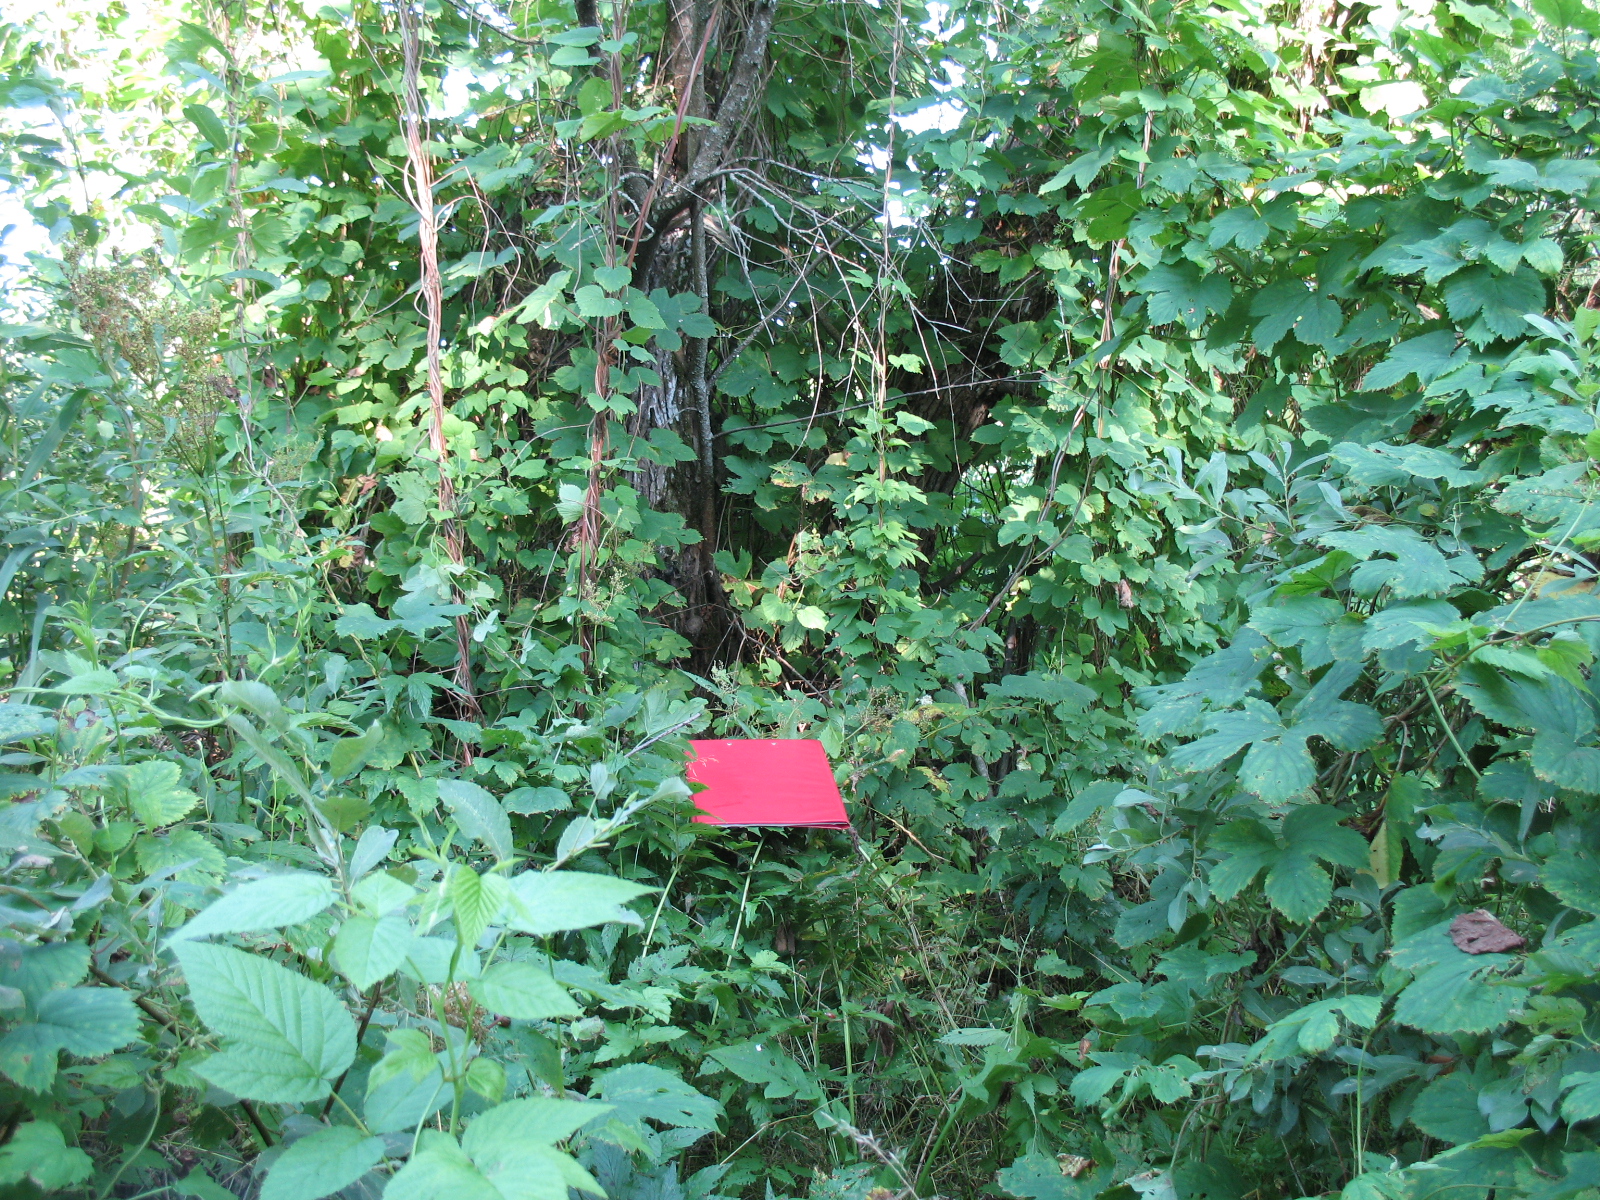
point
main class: Woodland
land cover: Broadleaved woodland
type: mire and swamp forests
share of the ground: 25 - 50 %
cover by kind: broadleaved forest trees 40 %, shrubs 30 %, herbaceous plants 30 %
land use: Forestry
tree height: > 5 m
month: August
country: LV
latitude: 56.4813
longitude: 25.2303
